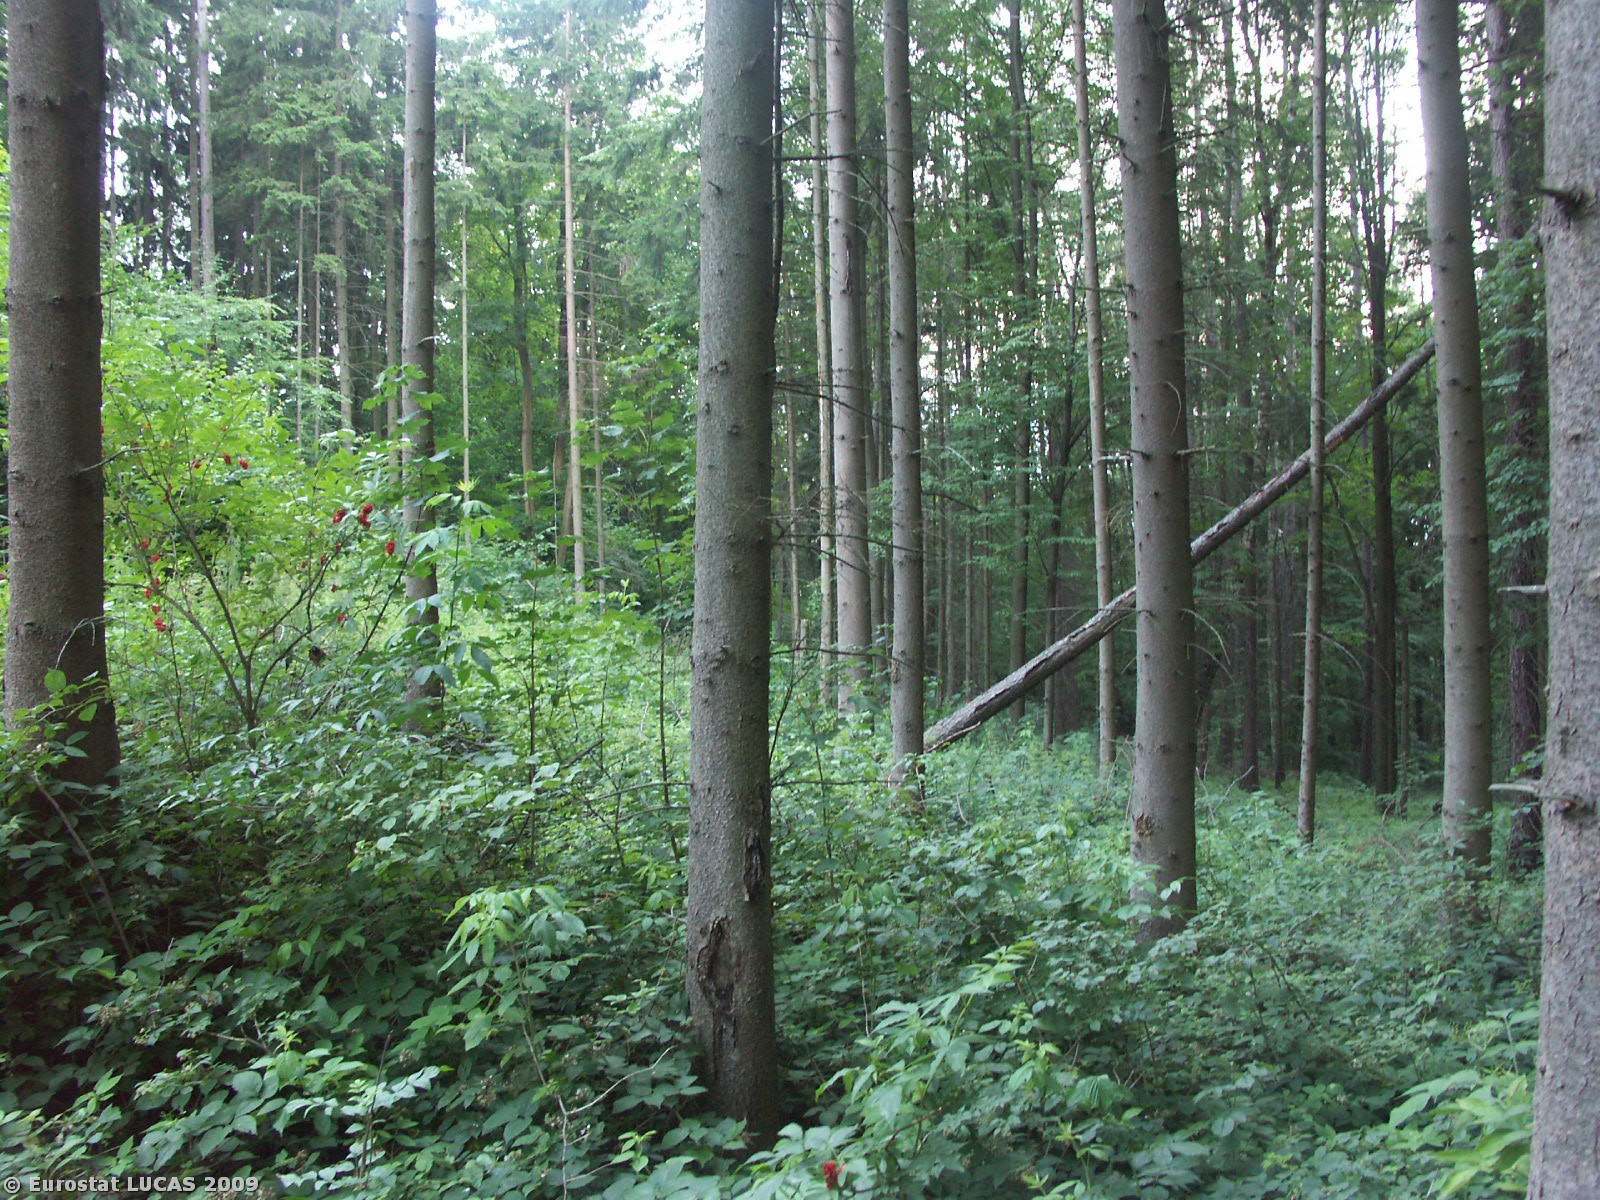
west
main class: Woodland
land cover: Coniferous woodland
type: hemiboreal forest and nemoral coniferous forest and mixed broadleaved-coniferous forest
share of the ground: > 75 %
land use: Forestry
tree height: > 5 m
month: July
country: CZ
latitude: 49.9357
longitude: 16.6539
